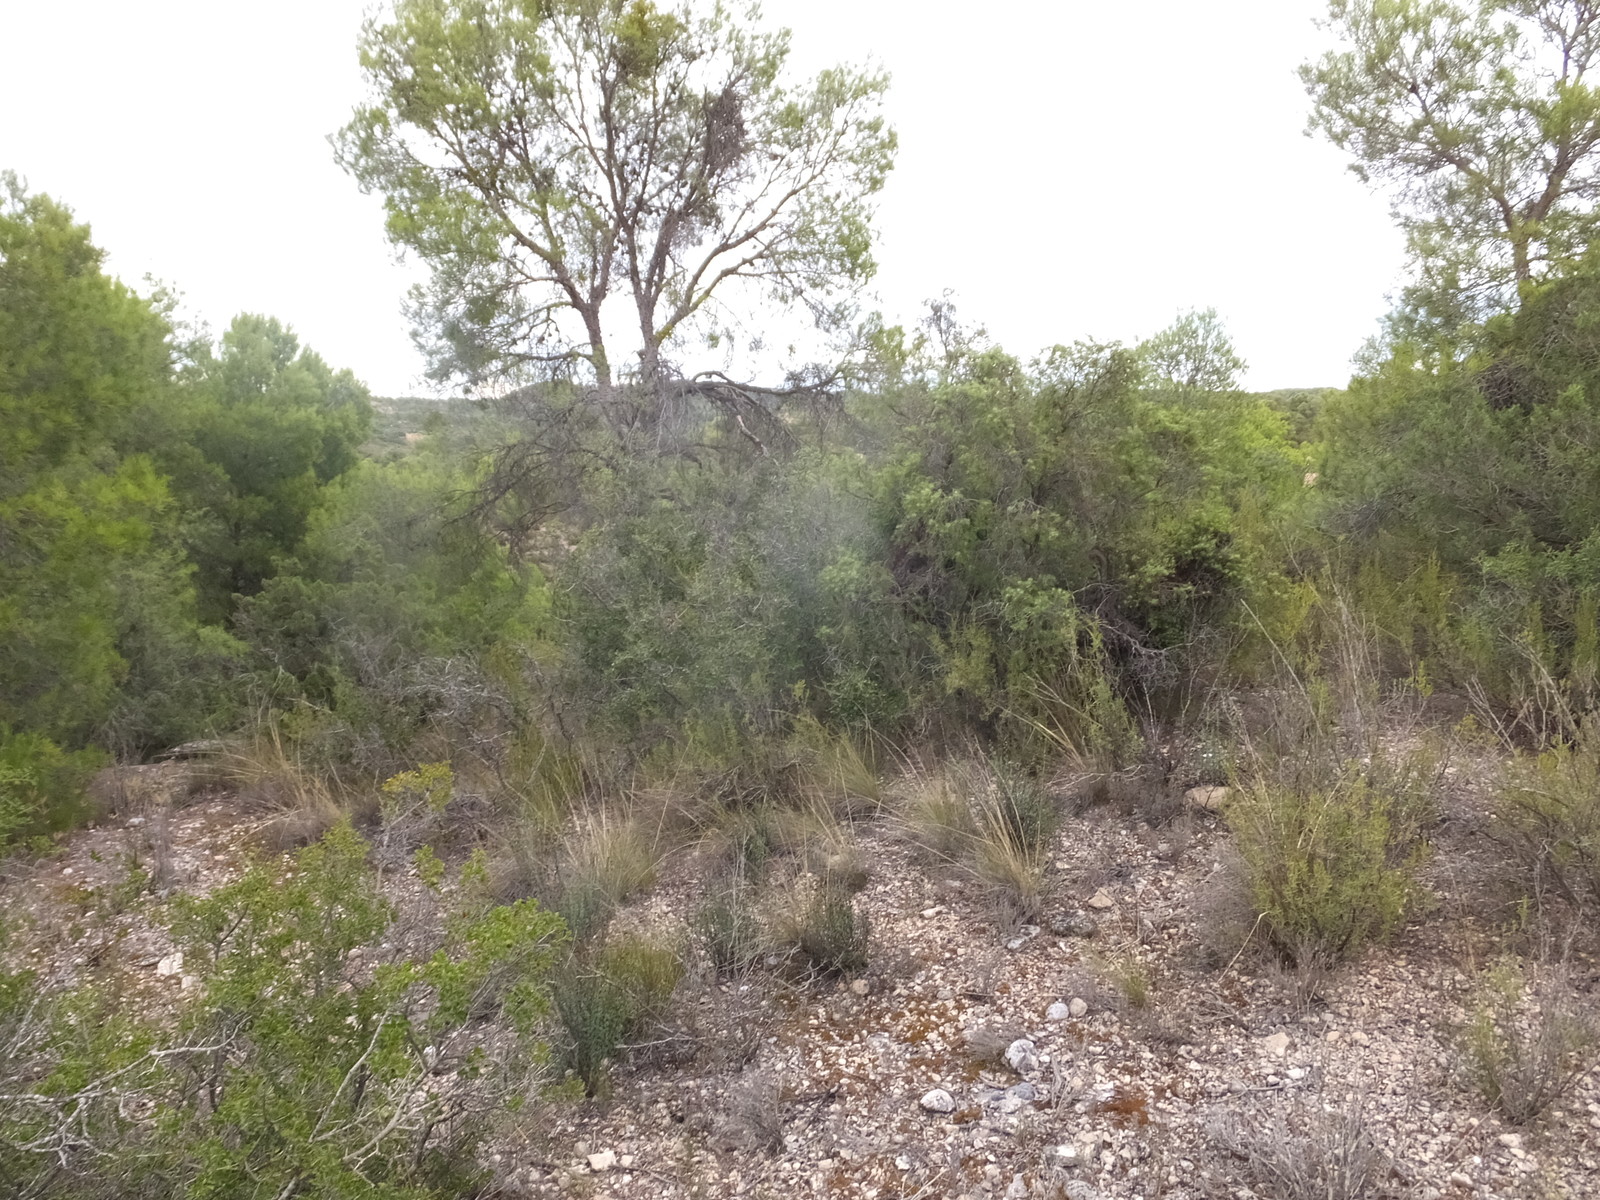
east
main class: Woodland
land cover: Pine dominated mixed woodland
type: coniferous forest of the mediterranean region
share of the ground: 50 - 75 %
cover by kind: coniferous forest trees 60 %, broadleaved forest trees 20 %, shrubs 20 %
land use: Forestry
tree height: > 5 m
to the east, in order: Pine dominated mixed woodland; Shrubland with sparse tree cover; Nuts trees; Shruby margins; Nuts trees; Shrubland with sparse tree cover; Artificial constructions in urban areas; Shrubland with sparse tree cover; Tracks; Shrubland with sparse tree cover; Nuts trees
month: August
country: ES
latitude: 41.1800
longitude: 0.2261
